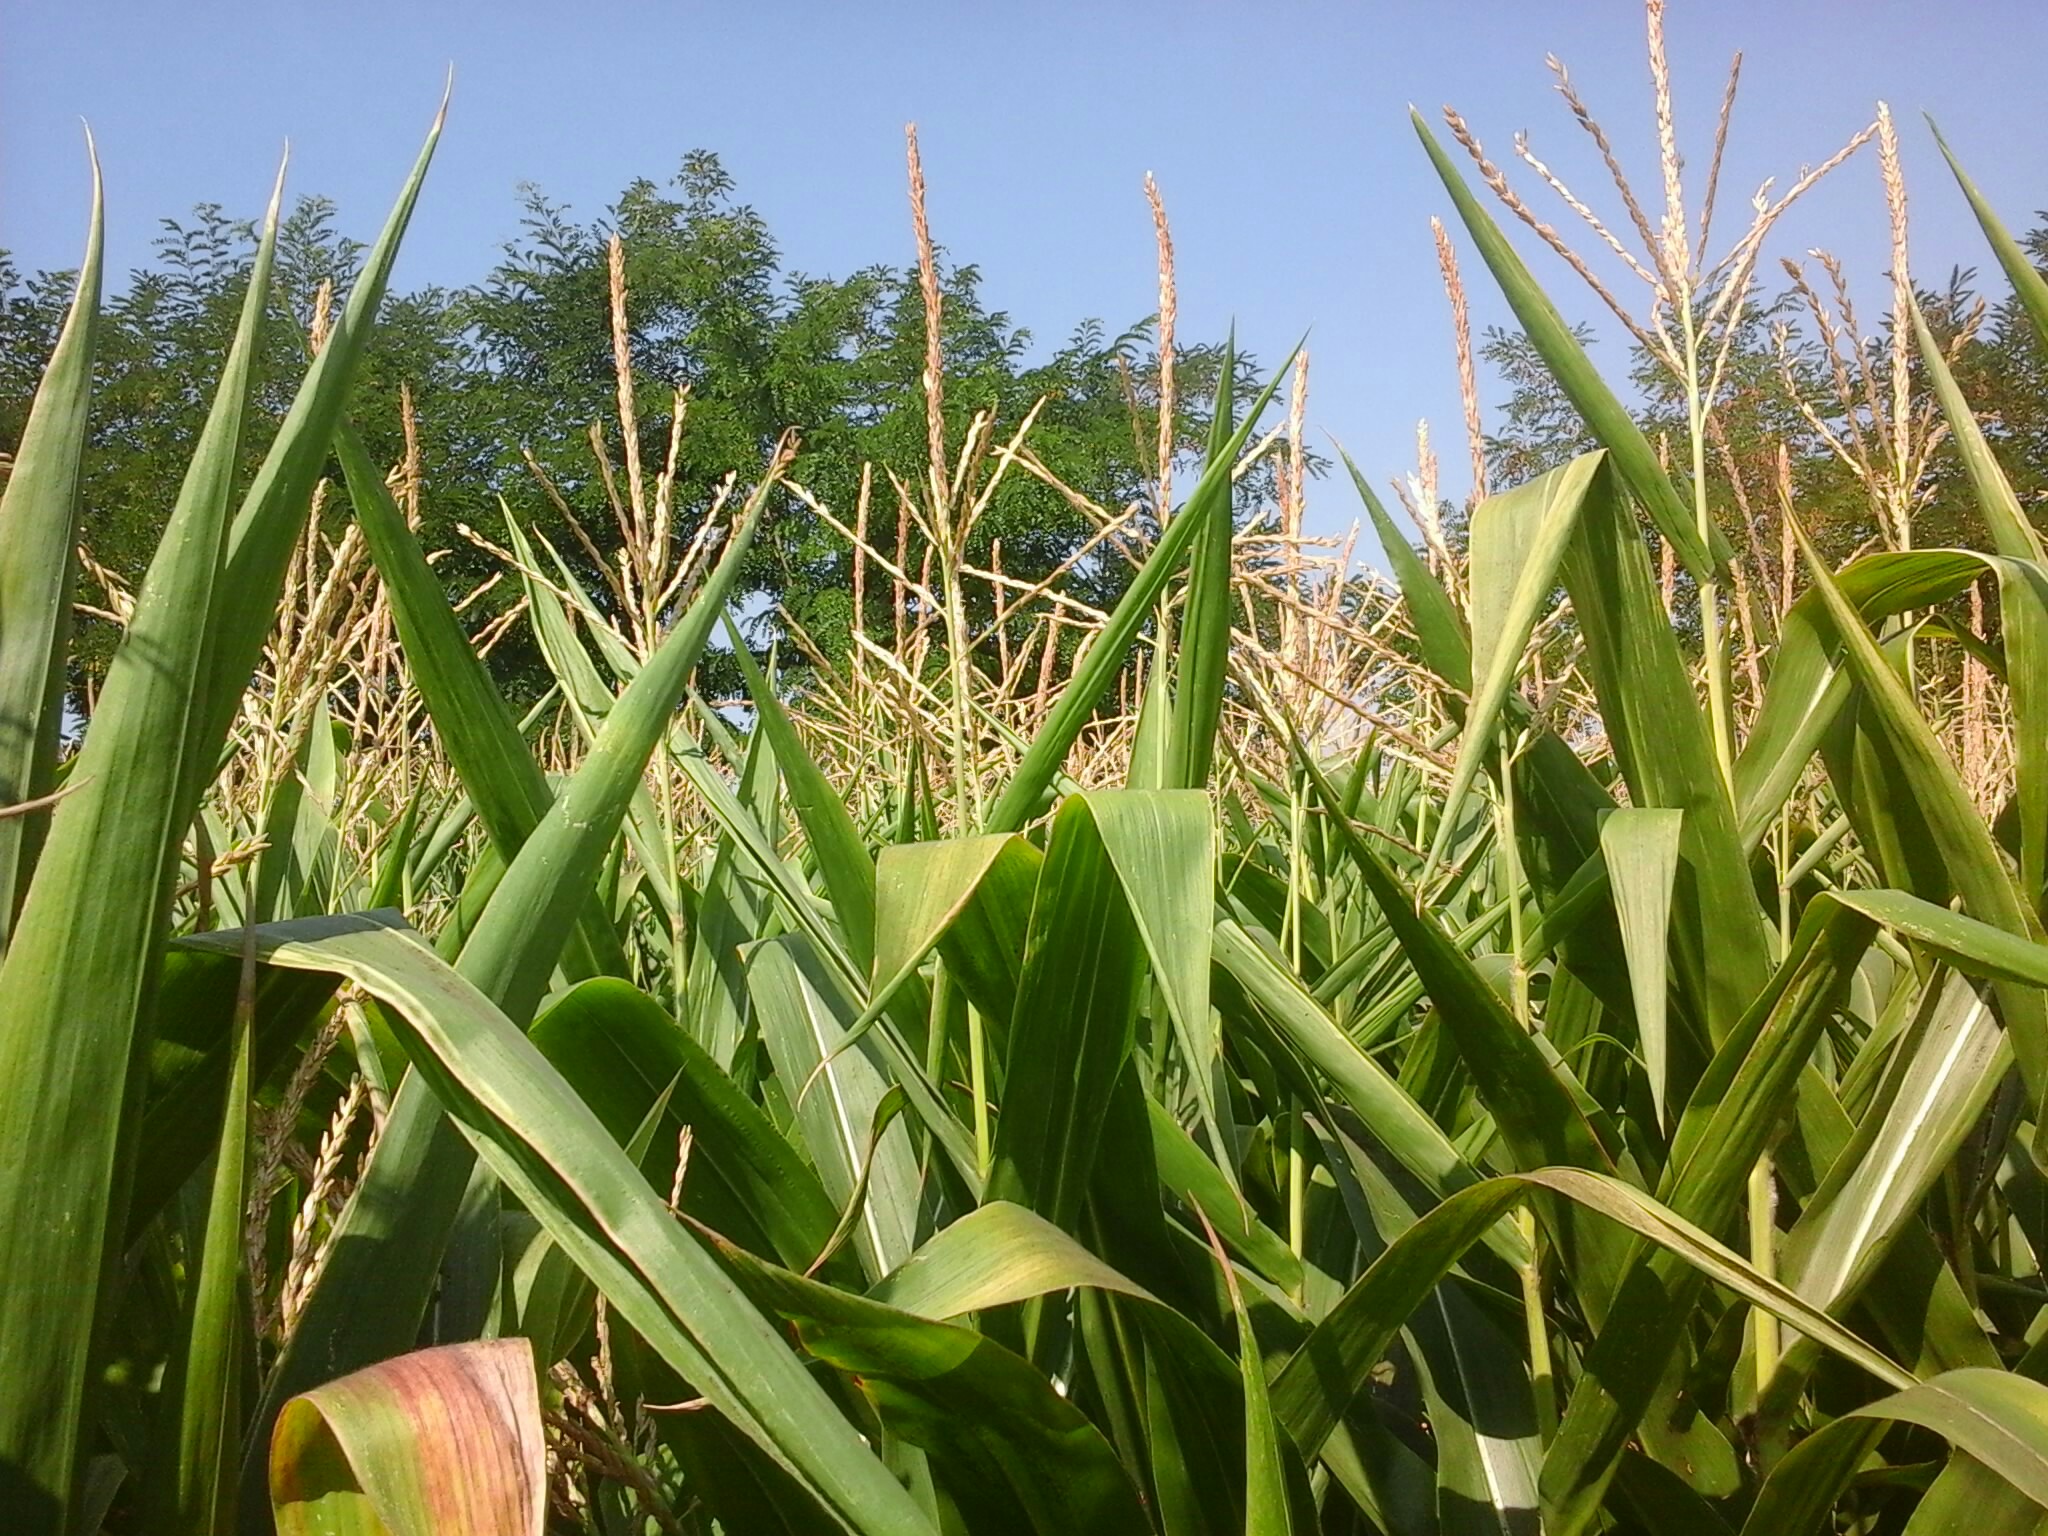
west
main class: Cropland
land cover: Maize
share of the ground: > 75 %
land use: Agriculture (excluding fallow land and kitchen gardens)
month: August
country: HU
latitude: 47.6501
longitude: 17.9053
